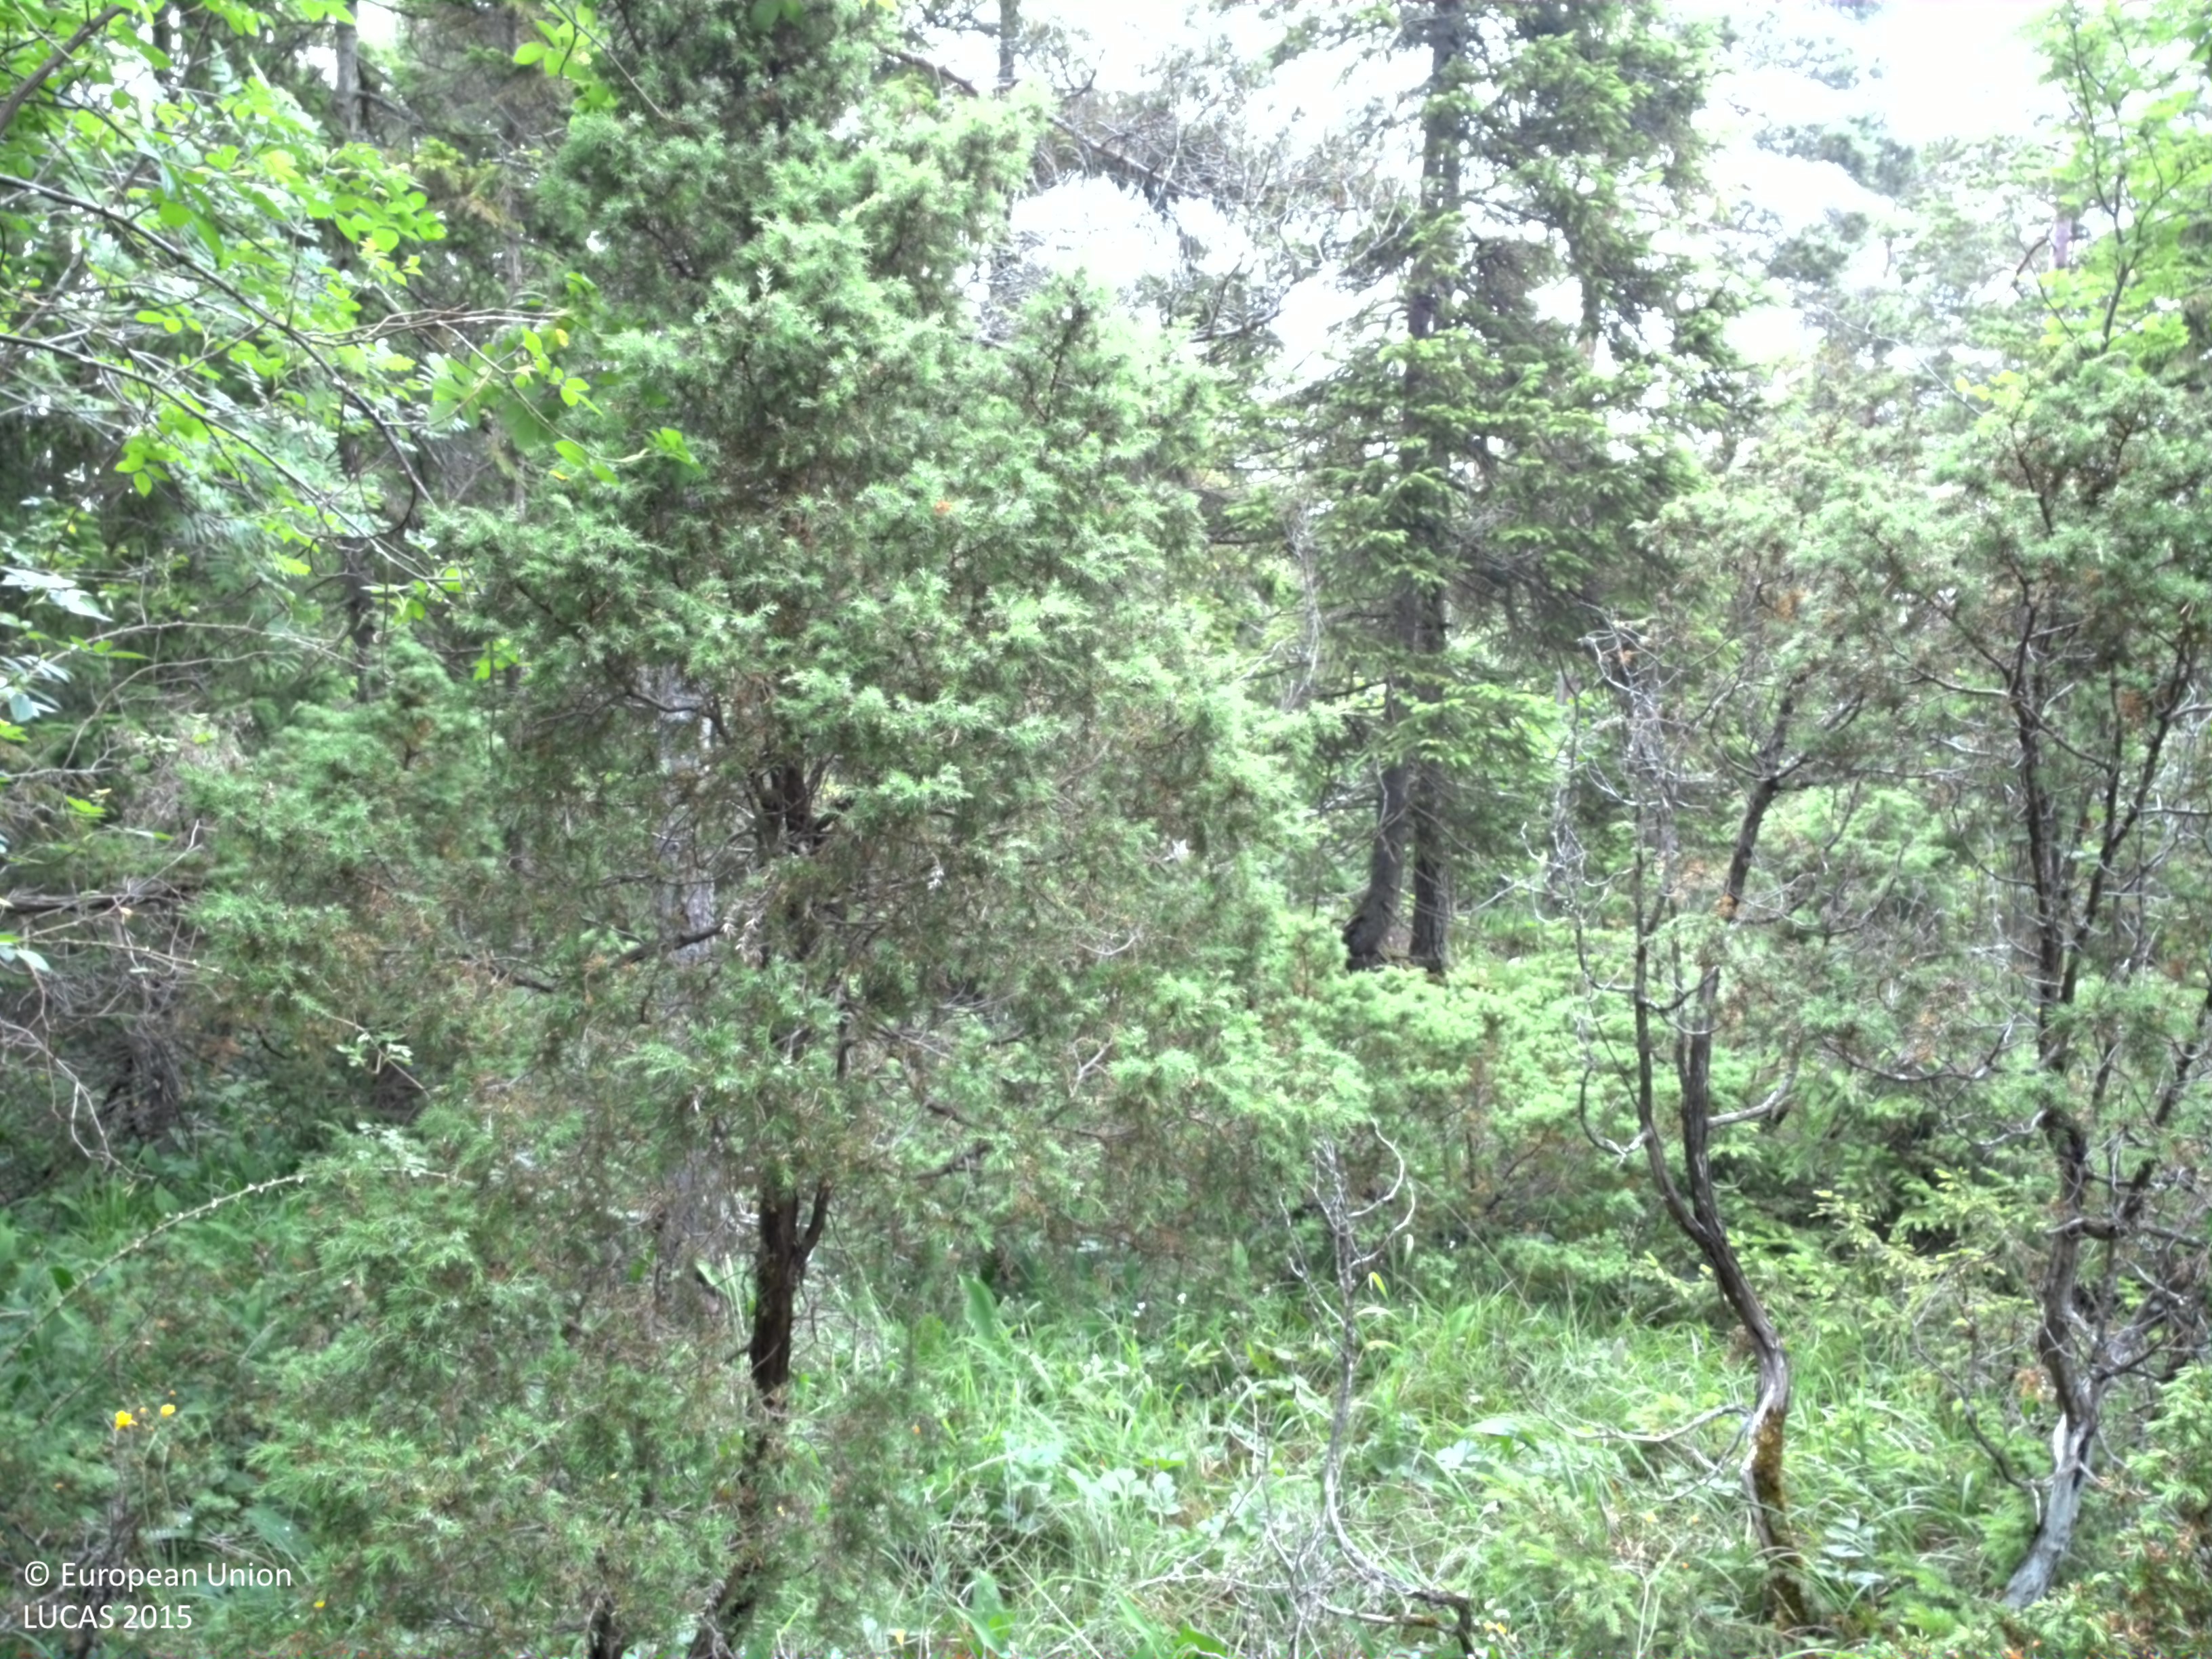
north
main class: Woodland
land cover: Other mixed woodland
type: hemiboreal forest and nemoral coniferous forest and mixed broadleaved-coniferous forest
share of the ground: > 75 %
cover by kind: coniferous forest trees 50 %, broadleaved forest trees 20 %, herbaceous plants 20 %, shrubs 10 %
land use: Forestry
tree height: > 5 m
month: July
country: SE
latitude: 57.3695
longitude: 18.2383
